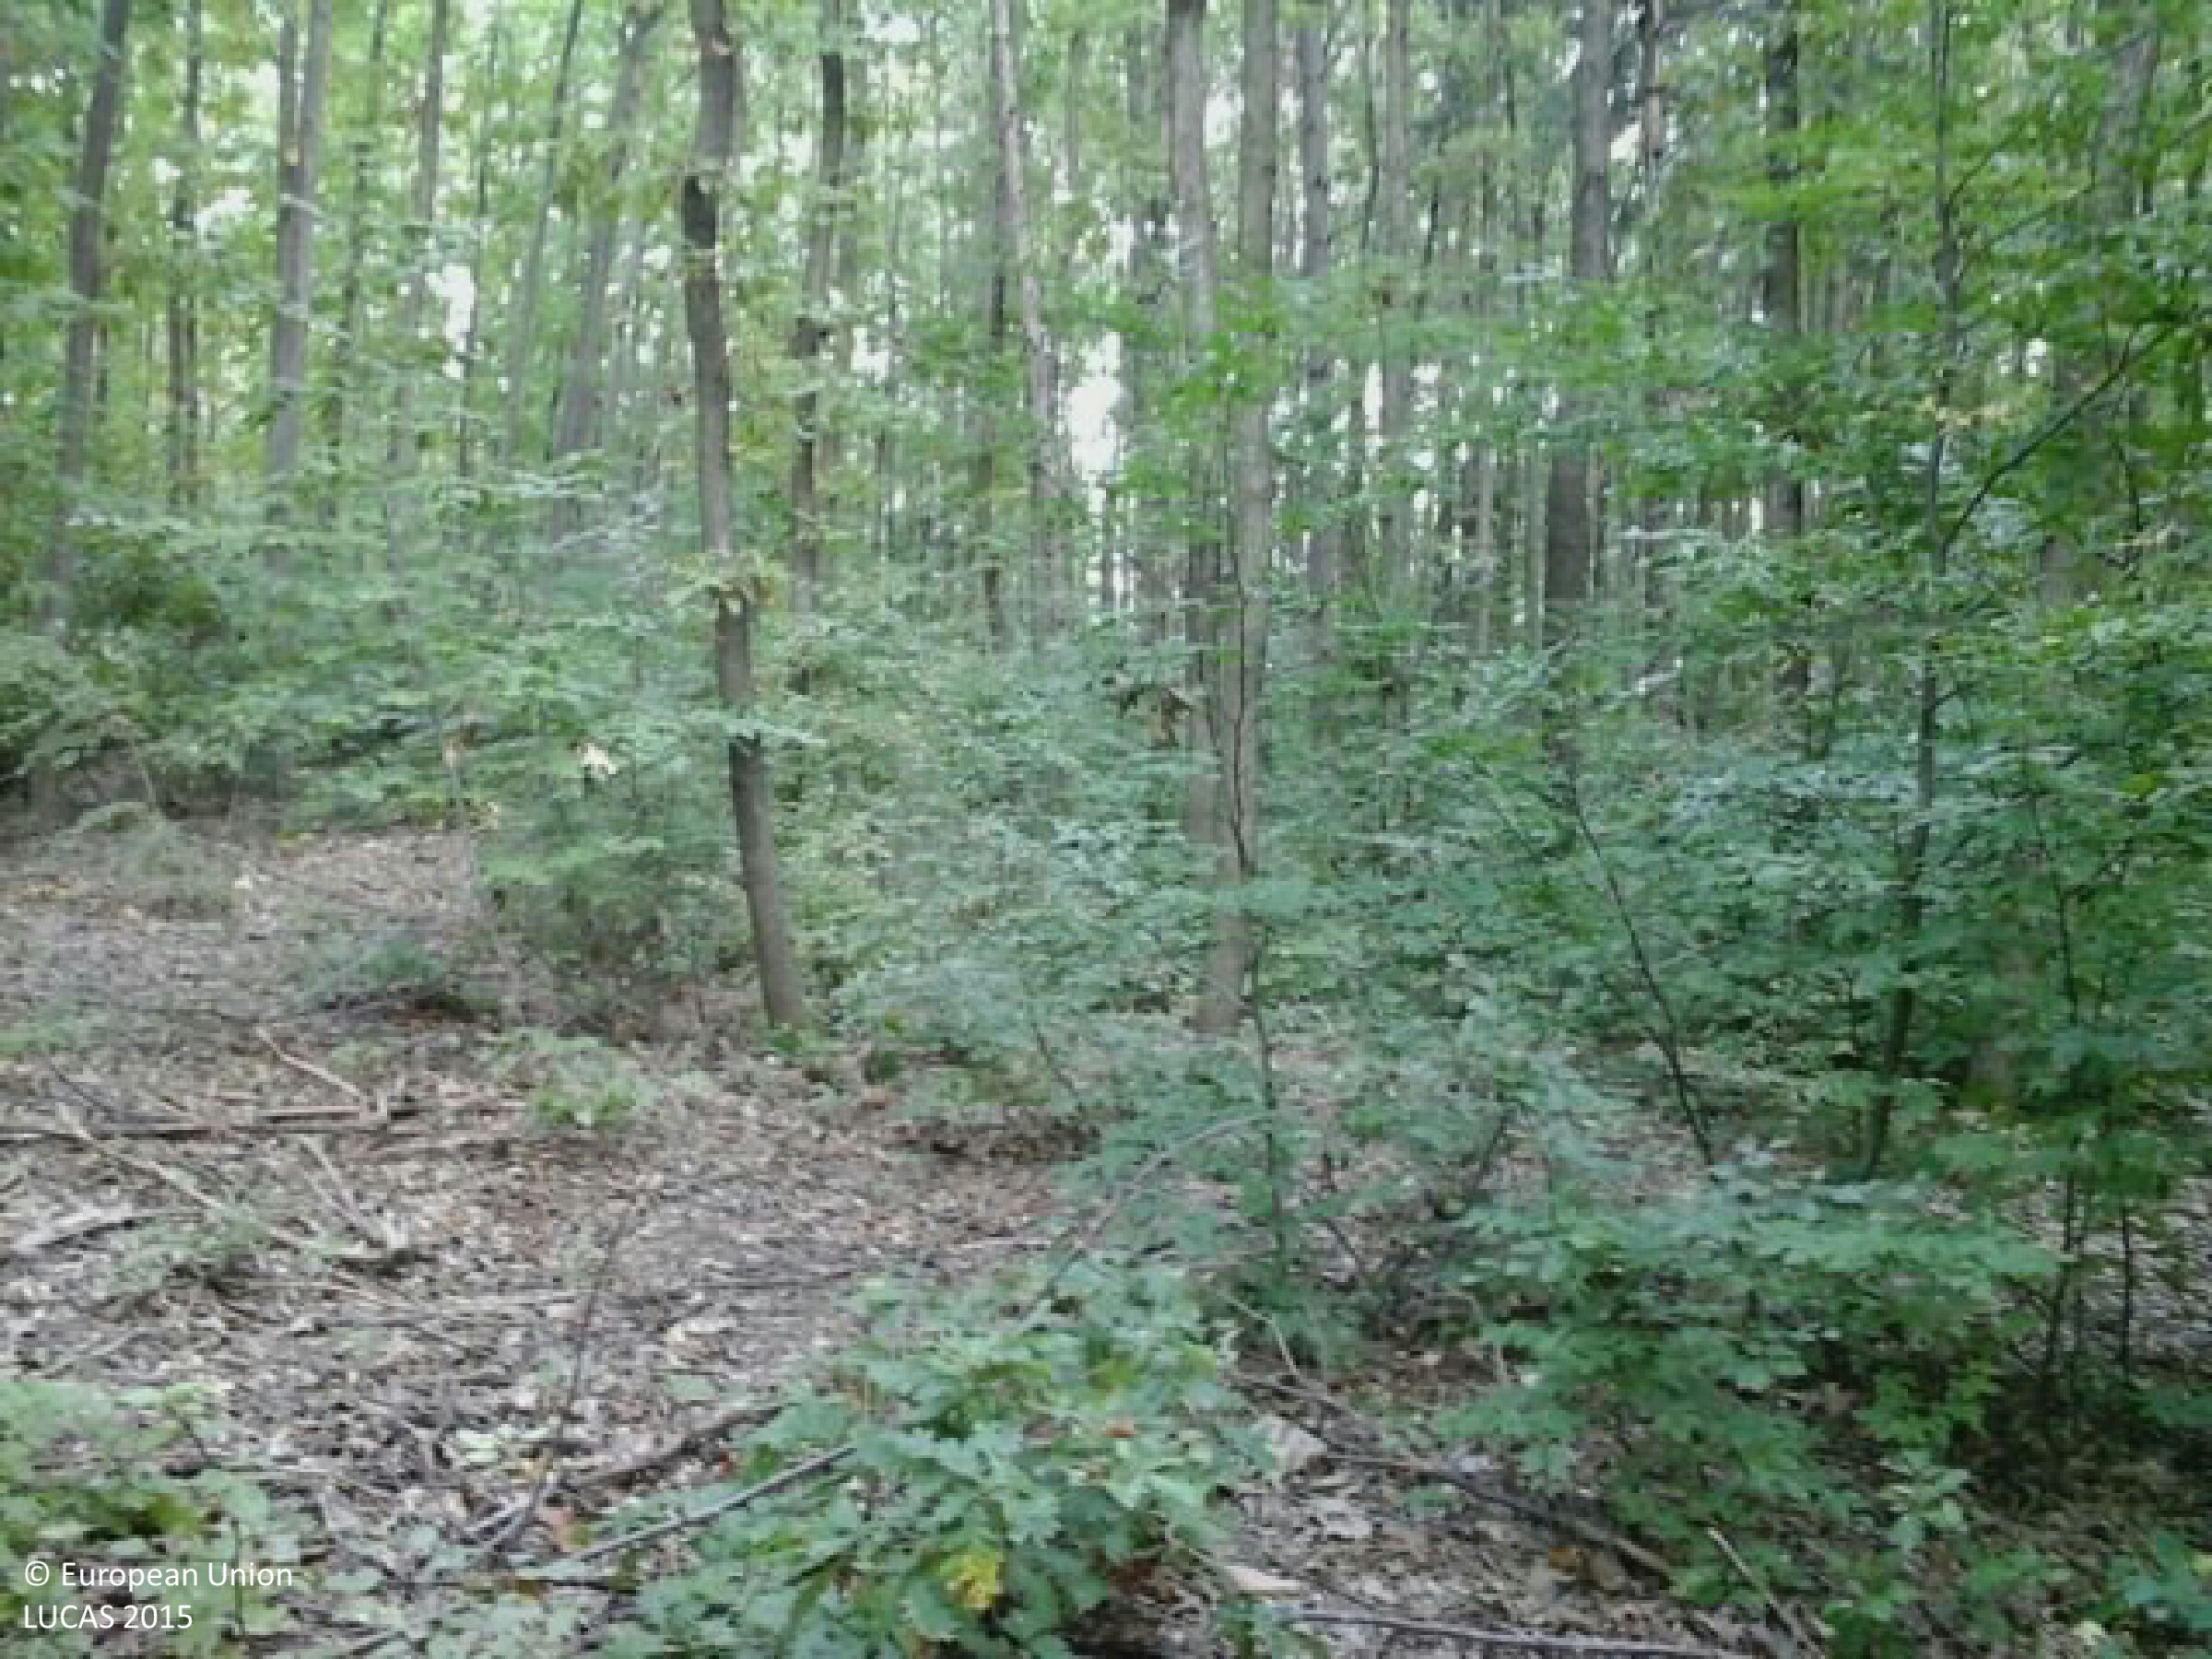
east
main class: Woodland
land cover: Broadleaved woodland
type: mesophytic deciduous forest
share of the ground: > 75 %
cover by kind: broadleaved forest trees 100 %
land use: Forestry
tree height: > 5 m
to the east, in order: Broadleaved woodland; Artificial constructions in urban areas
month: September
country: HU
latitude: 48.1438
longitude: 19.8516
